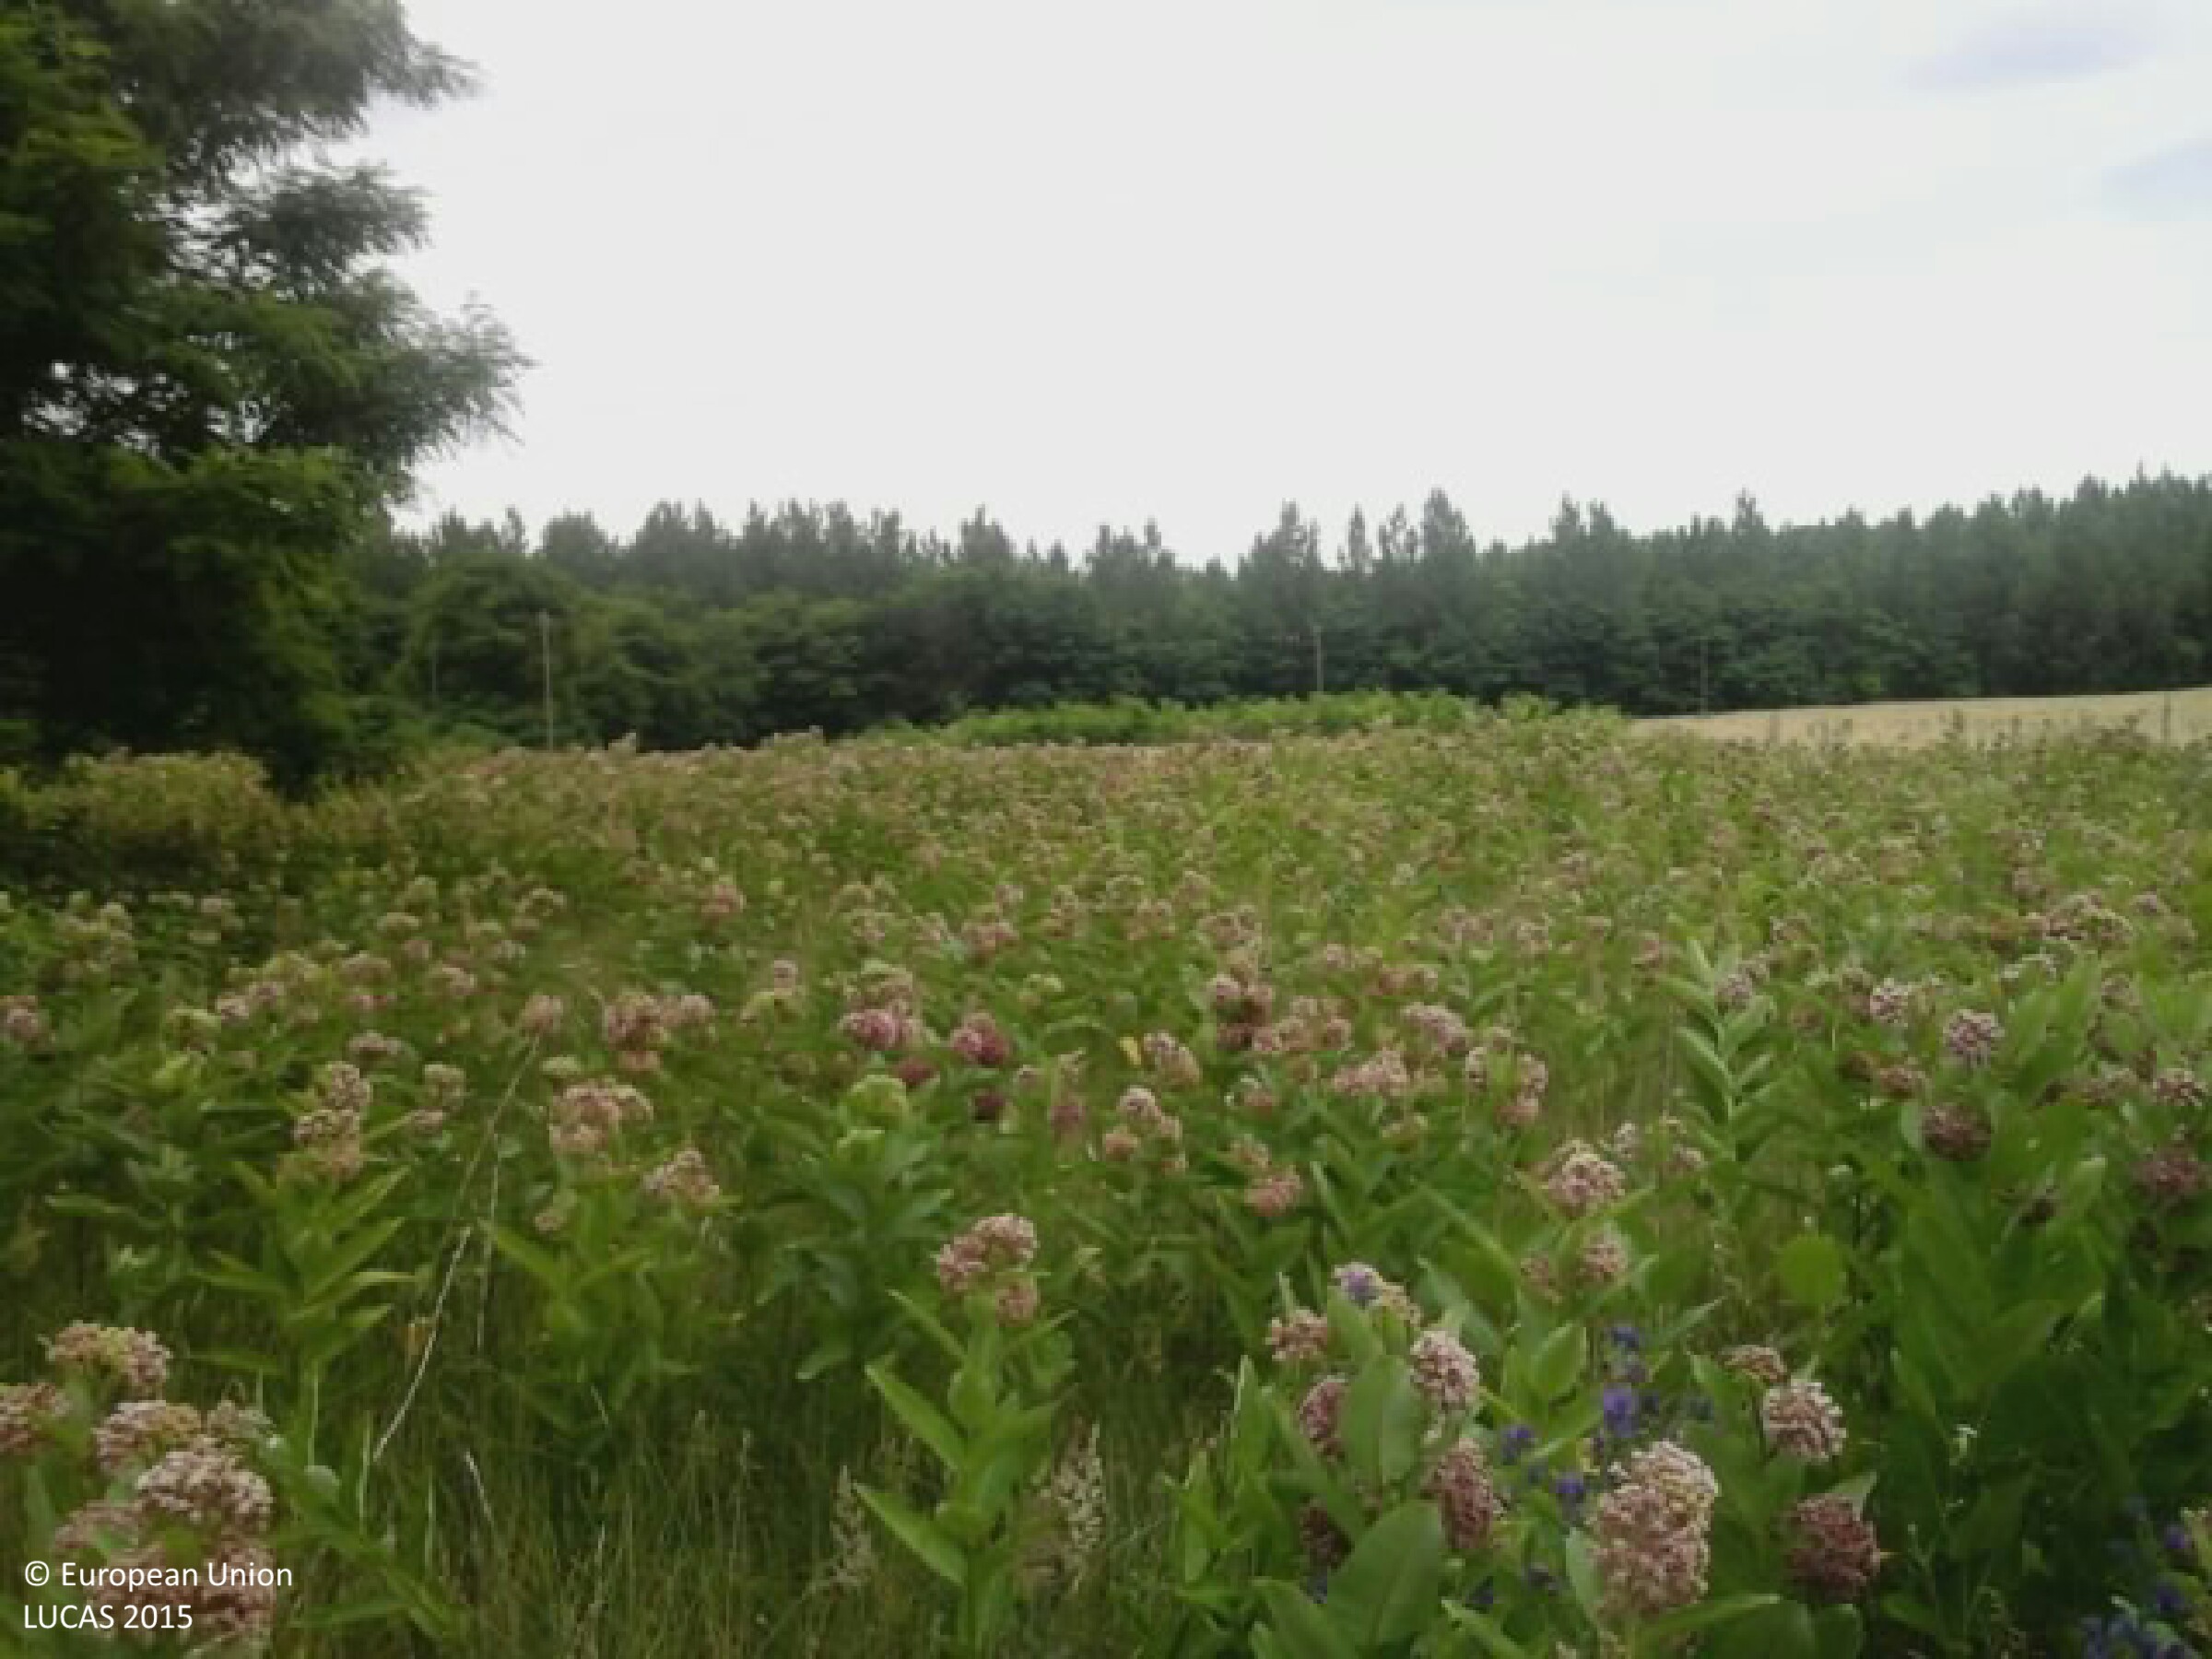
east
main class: Grassland
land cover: Grassland with sparse tree/shrub cover
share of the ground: > 75 %
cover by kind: herbaceous plants 95 %, broadleaved forest trees 5 %
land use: Agriculture (excluding fallow land and kitchen gardens)
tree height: > 5 m
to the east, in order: Grassland with sparse tree/shrub cover; Rye; Electric lines; Rye; Abandoned hedges; Artificial constructions in urban areas; Grassland with sparse tree/shrub cover; Broadleaved woodland
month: June
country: HU
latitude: 46.7620
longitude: 19.6960
